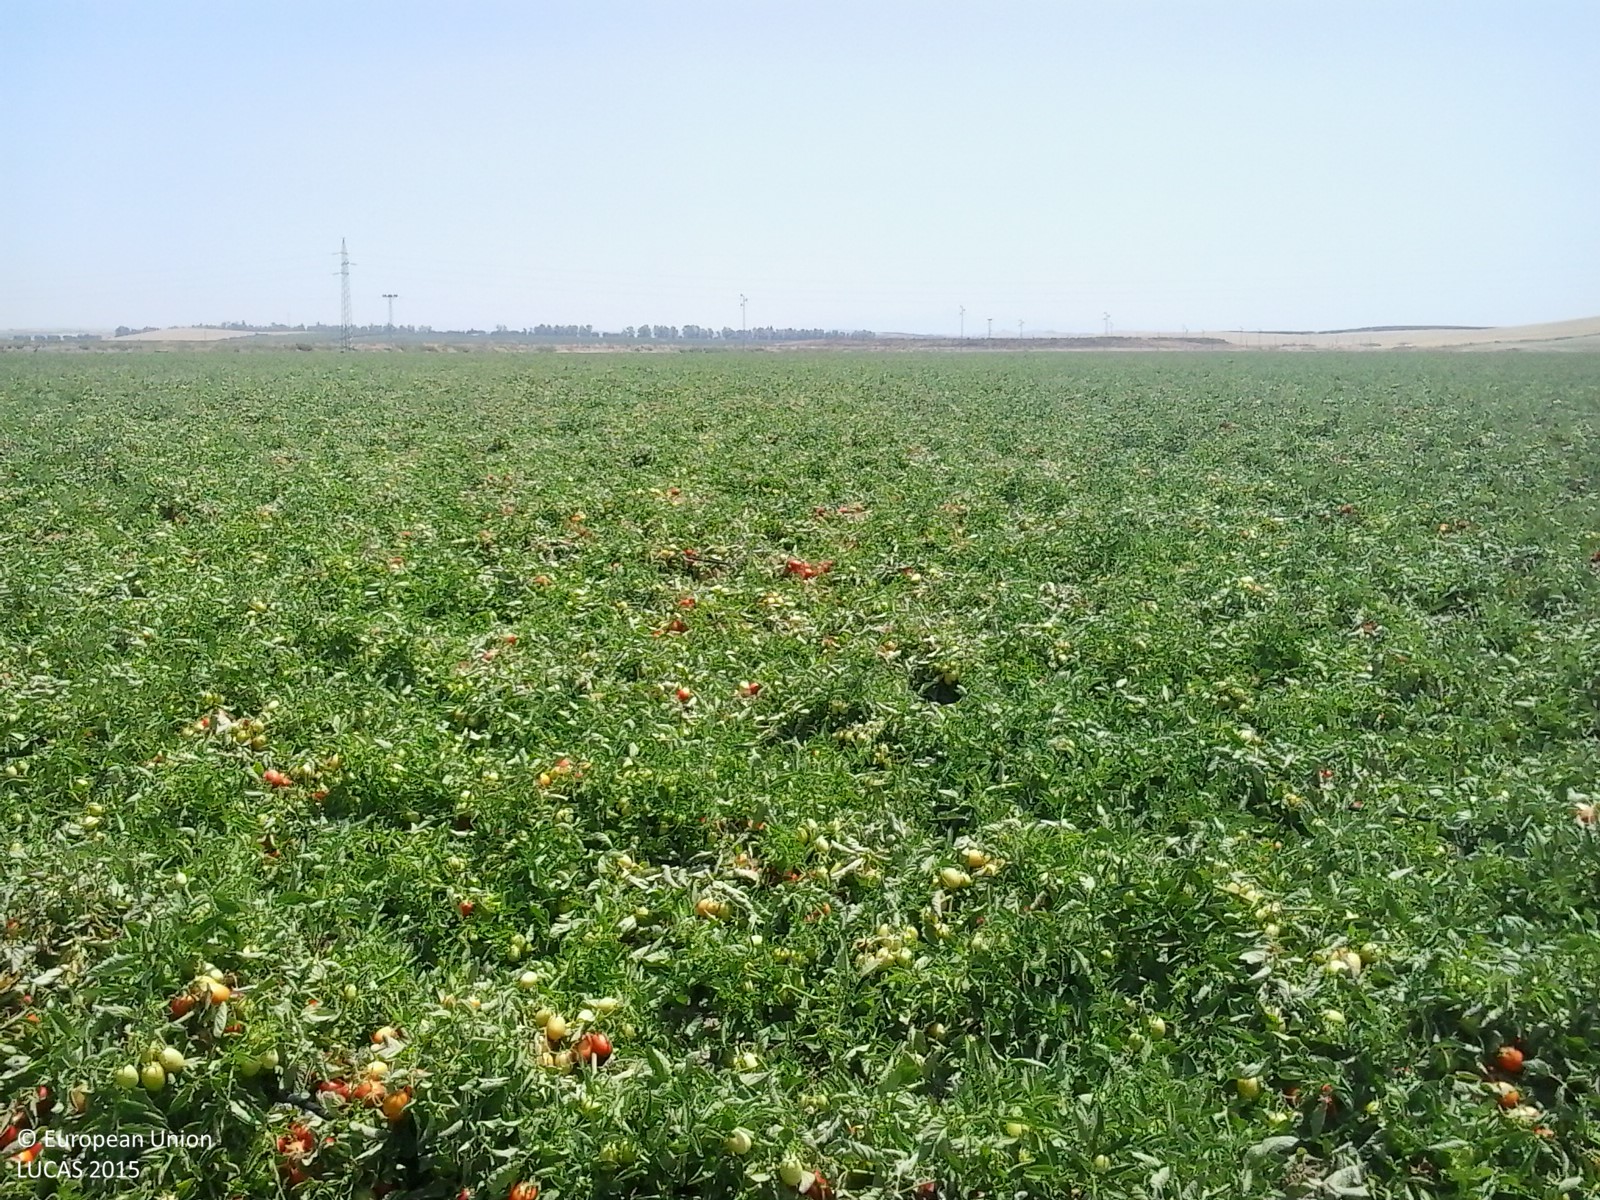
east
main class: Cropland
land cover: Tomatoes
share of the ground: > 75 %
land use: Agriculture (excluding fallow land and kitchen gardens)
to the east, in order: Tomatoes
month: July
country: ES
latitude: 36.9556
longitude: -5.9964
